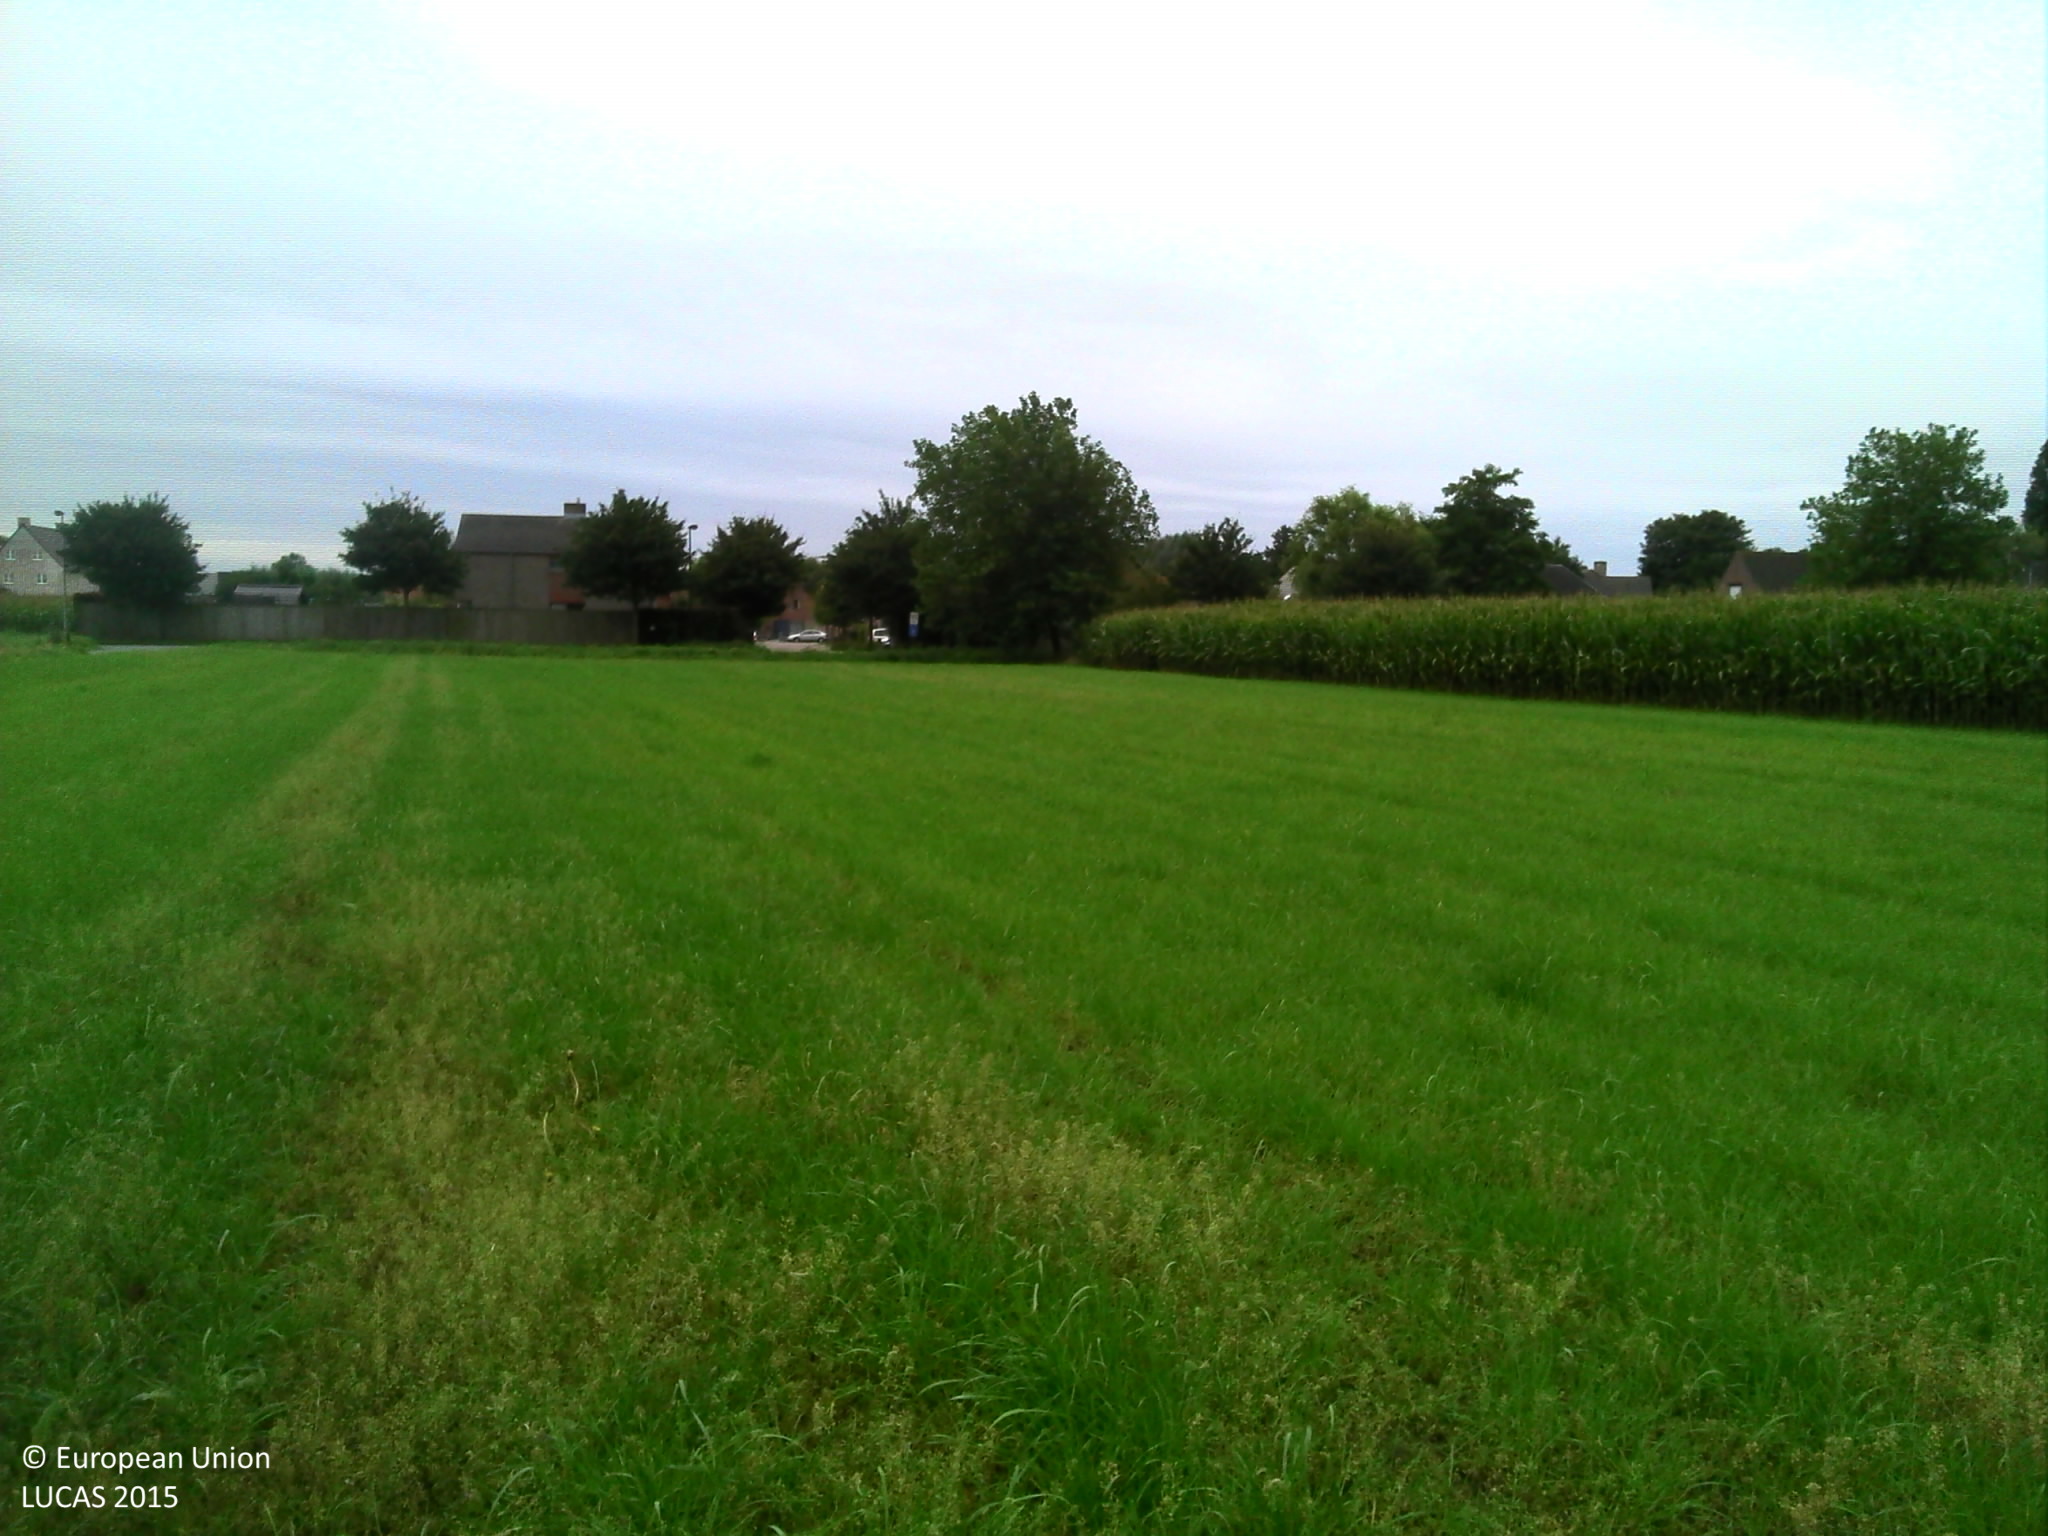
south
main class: Cropland
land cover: Temporary grasslands
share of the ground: > 75 %
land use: Agriculture (excluding fallow land and kitchen gardens)
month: September
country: BE
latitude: 51.1370
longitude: 2.9149
